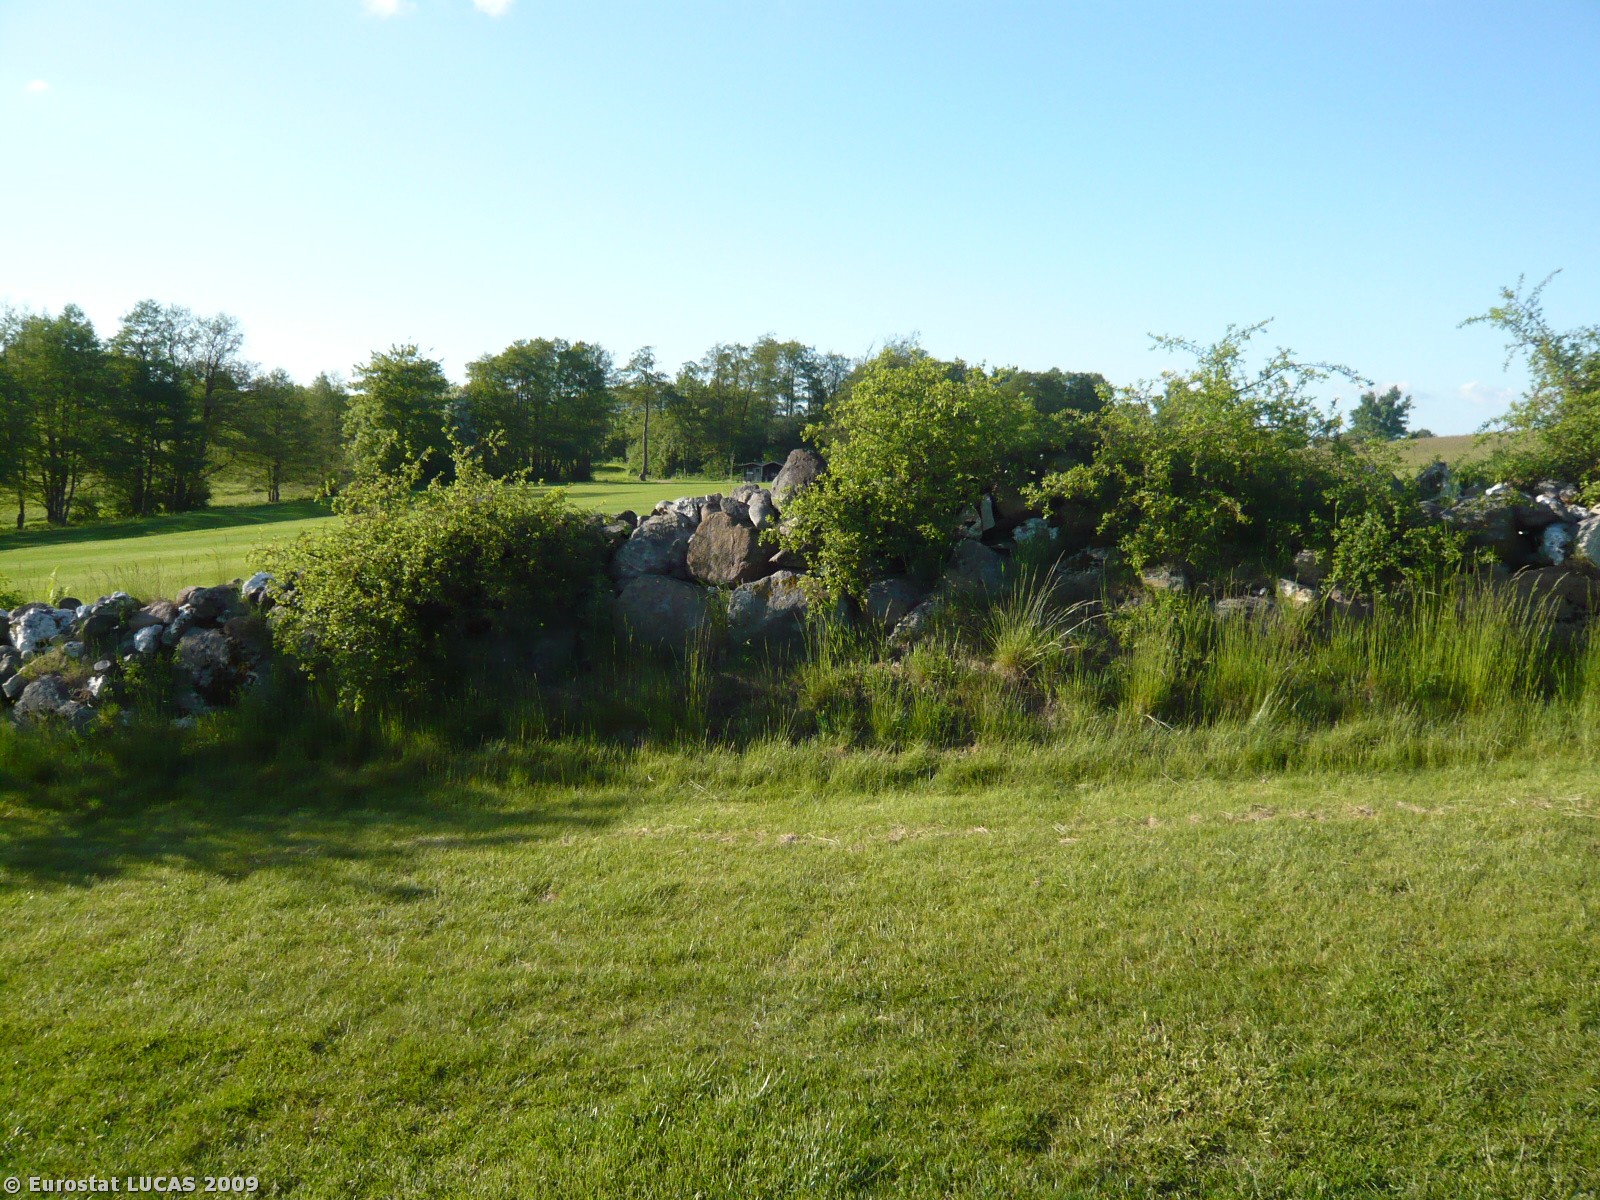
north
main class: Grassland
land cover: Grassland without tree/shrub cover
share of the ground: > 75 %
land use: Sport
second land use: Amenities, museums, leisure
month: May
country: DK
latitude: 55.3872
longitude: 11.5615
